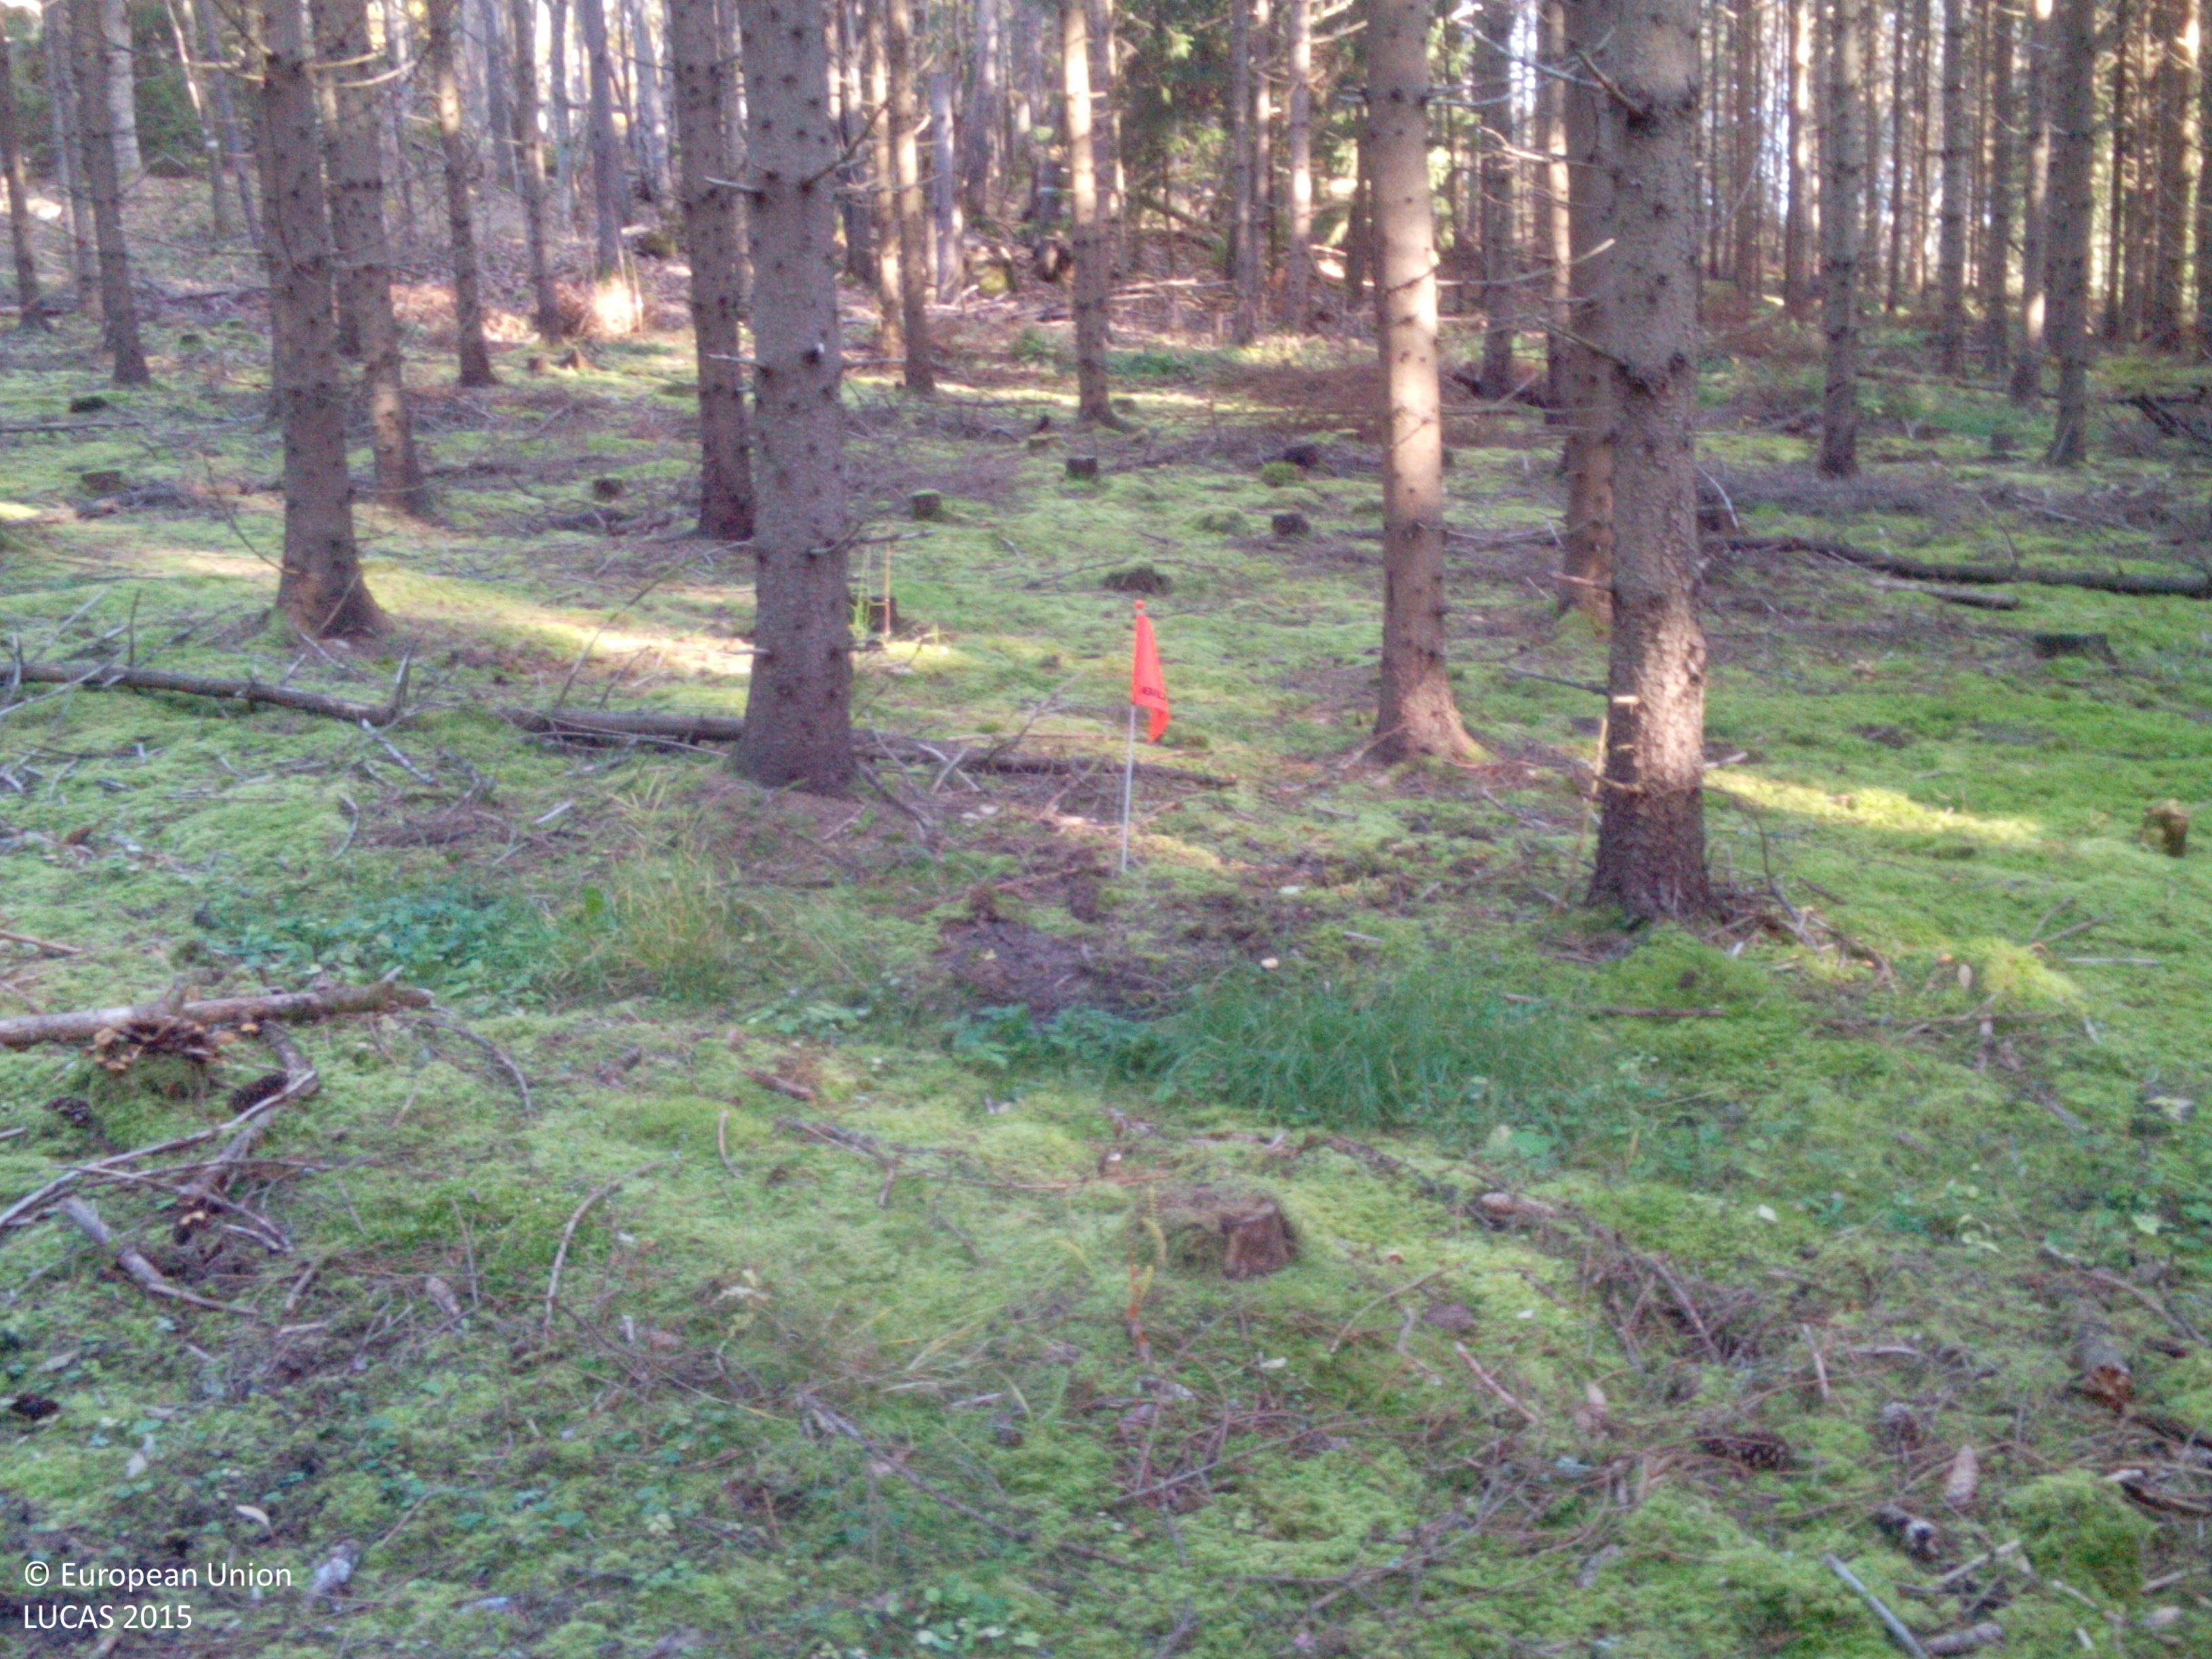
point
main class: Woodland
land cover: Spruce dominated coniferous woodland
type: boreal forest
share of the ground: > 75 %
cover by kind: coniferous forest trees 85 %, lichens and mosses 10 %, herbaceous plants 5 %
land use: Forestry
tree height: > 5 m
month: October
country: SE
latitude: 59.0343
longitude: 16.5635
